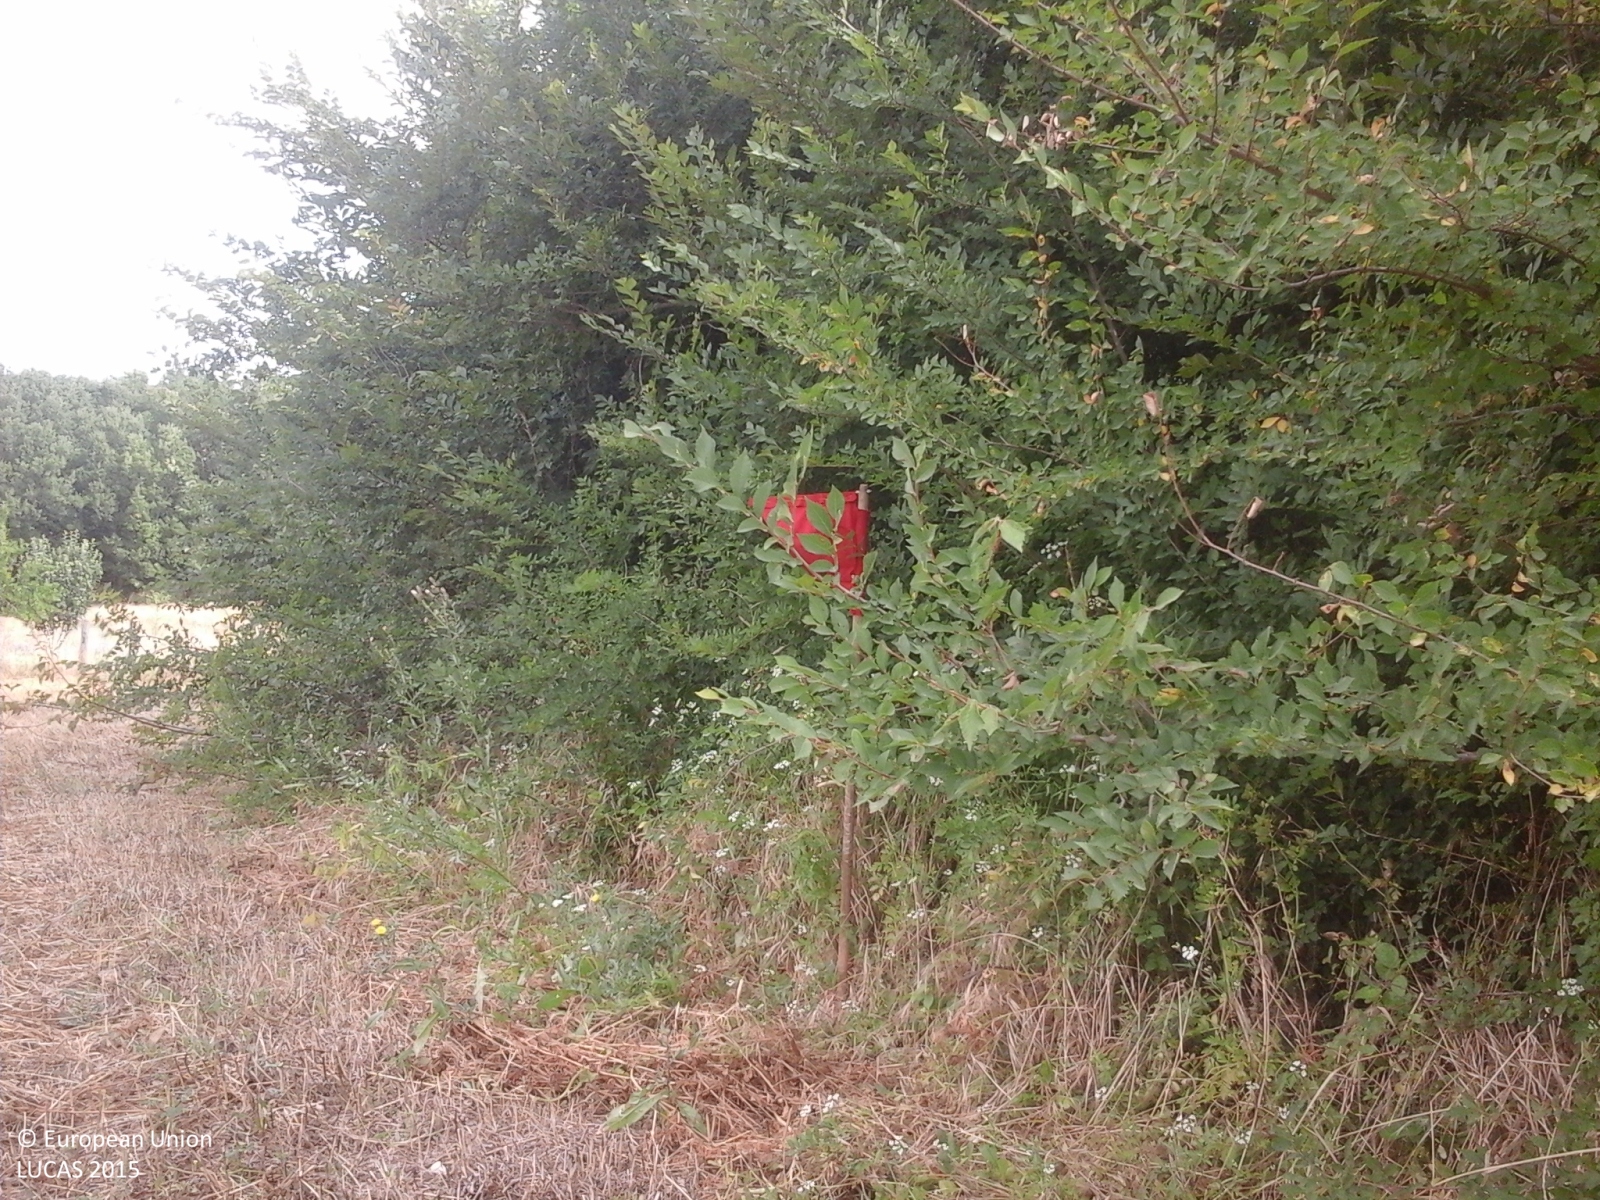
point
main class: Woodland
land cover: Broadleaved woodland
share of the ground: > 75 %
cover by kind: broadleaved forest trees 90 %, shrubs 10 %
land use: Abandoned areas
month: June
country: IT
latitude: 41.0213
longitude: 15.1300
